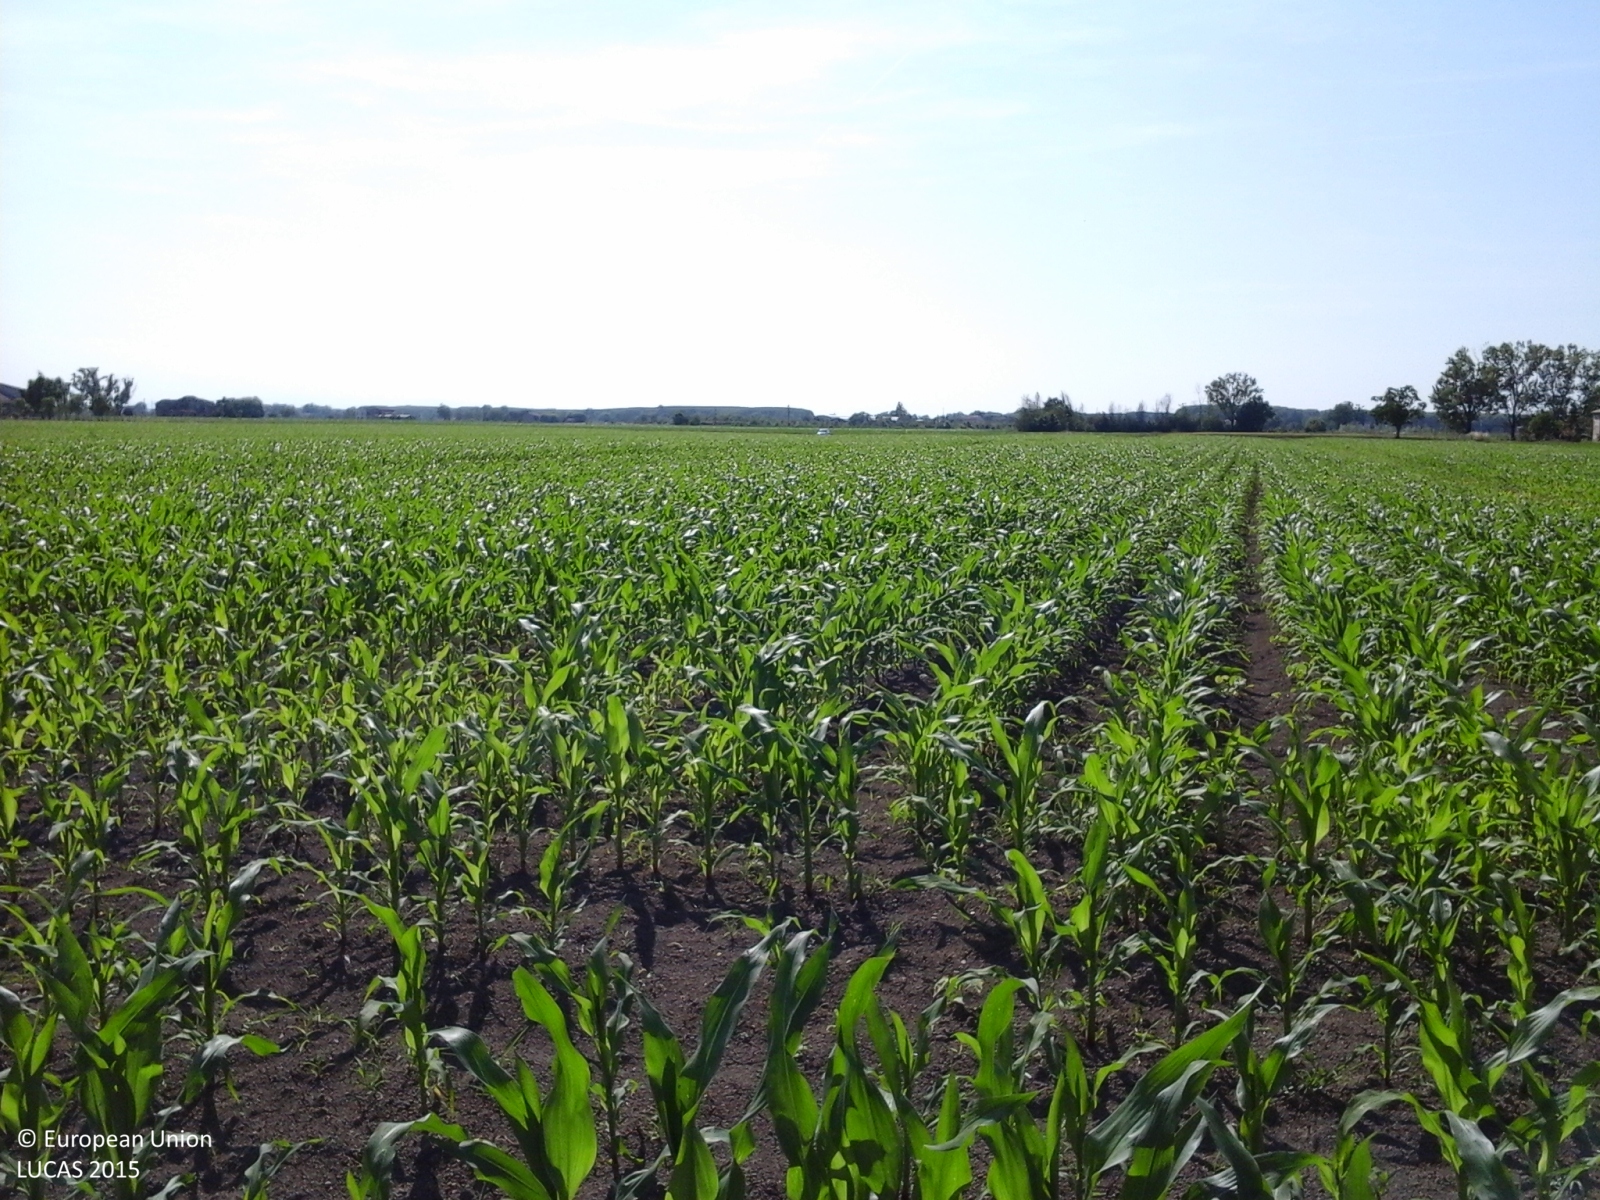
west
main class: Cropland
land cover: Maize
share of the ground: 25 - 50 %
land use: Agriculture (excluding fallow land and kitchen gardens)
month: May
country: IT
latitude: 44.8543
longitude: 10.4925
